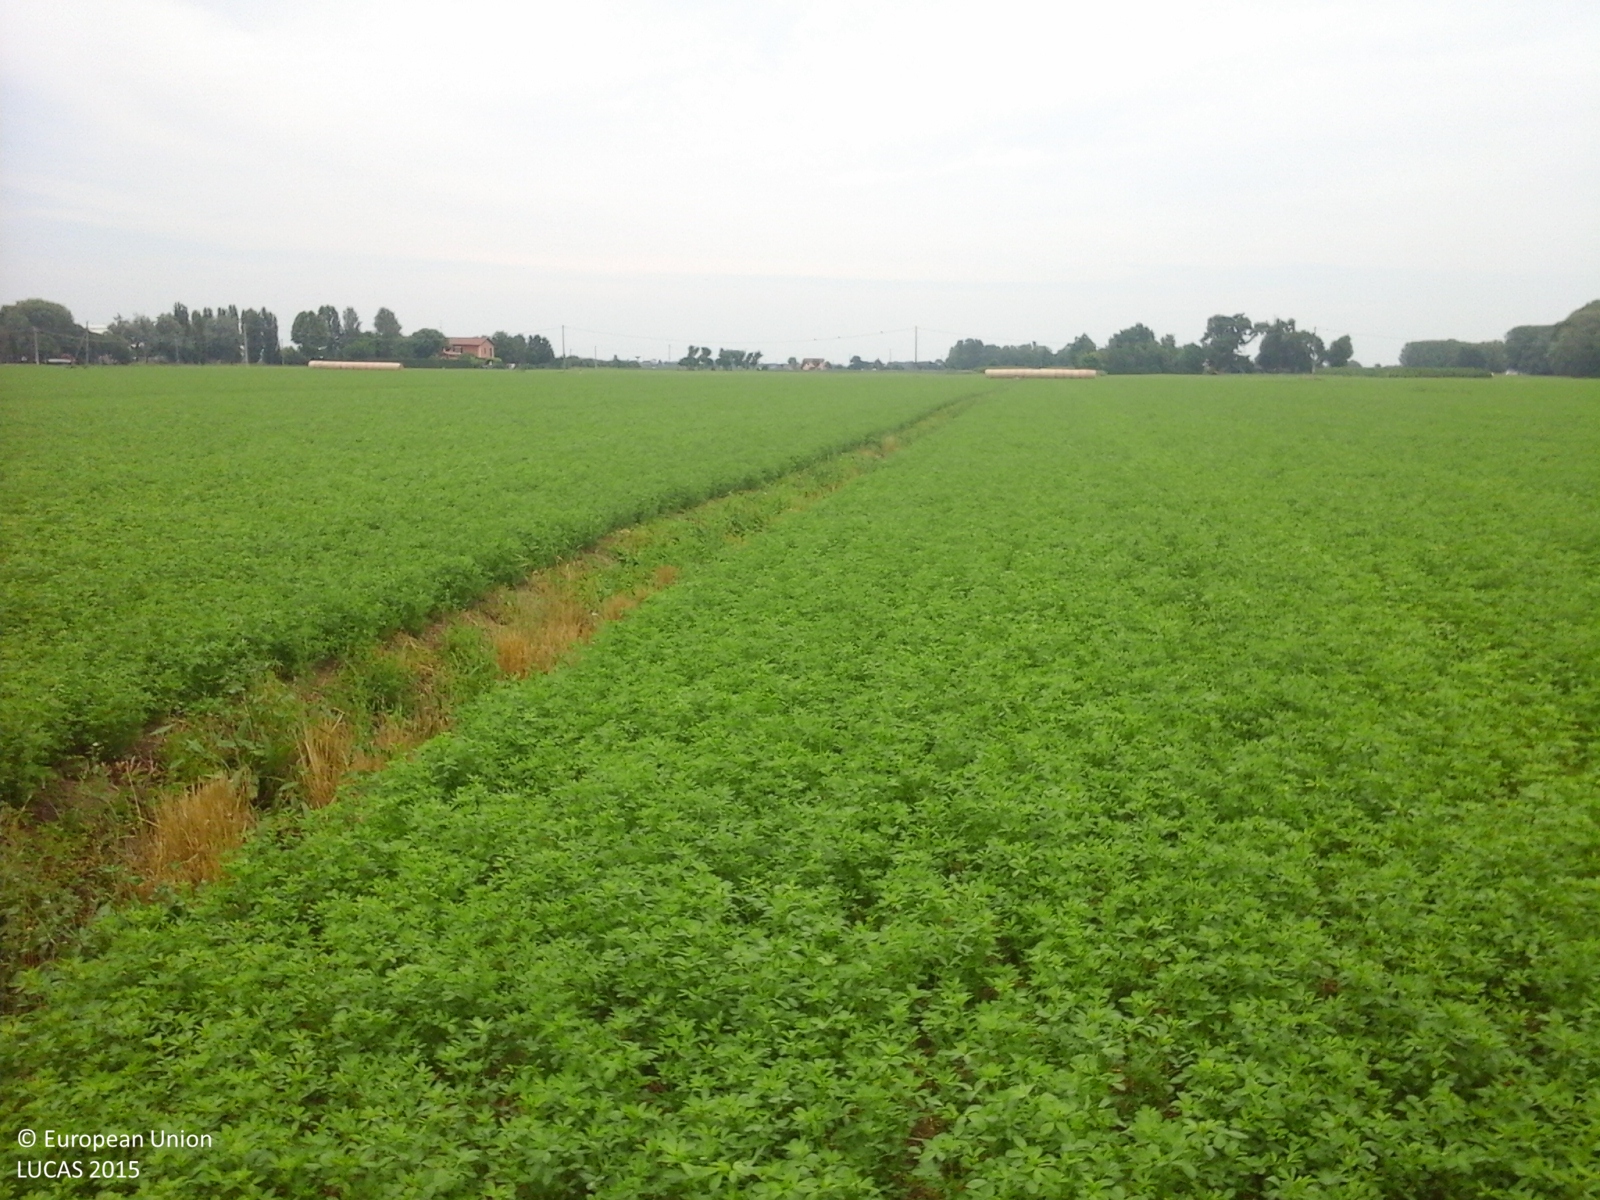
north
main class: Cropland
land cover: Lucerne
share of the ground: > 75 %
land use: Agriculture (excluding fallow land and kitchen gardens)
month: June
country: IT
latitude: 44.6151
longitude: 11.1192
